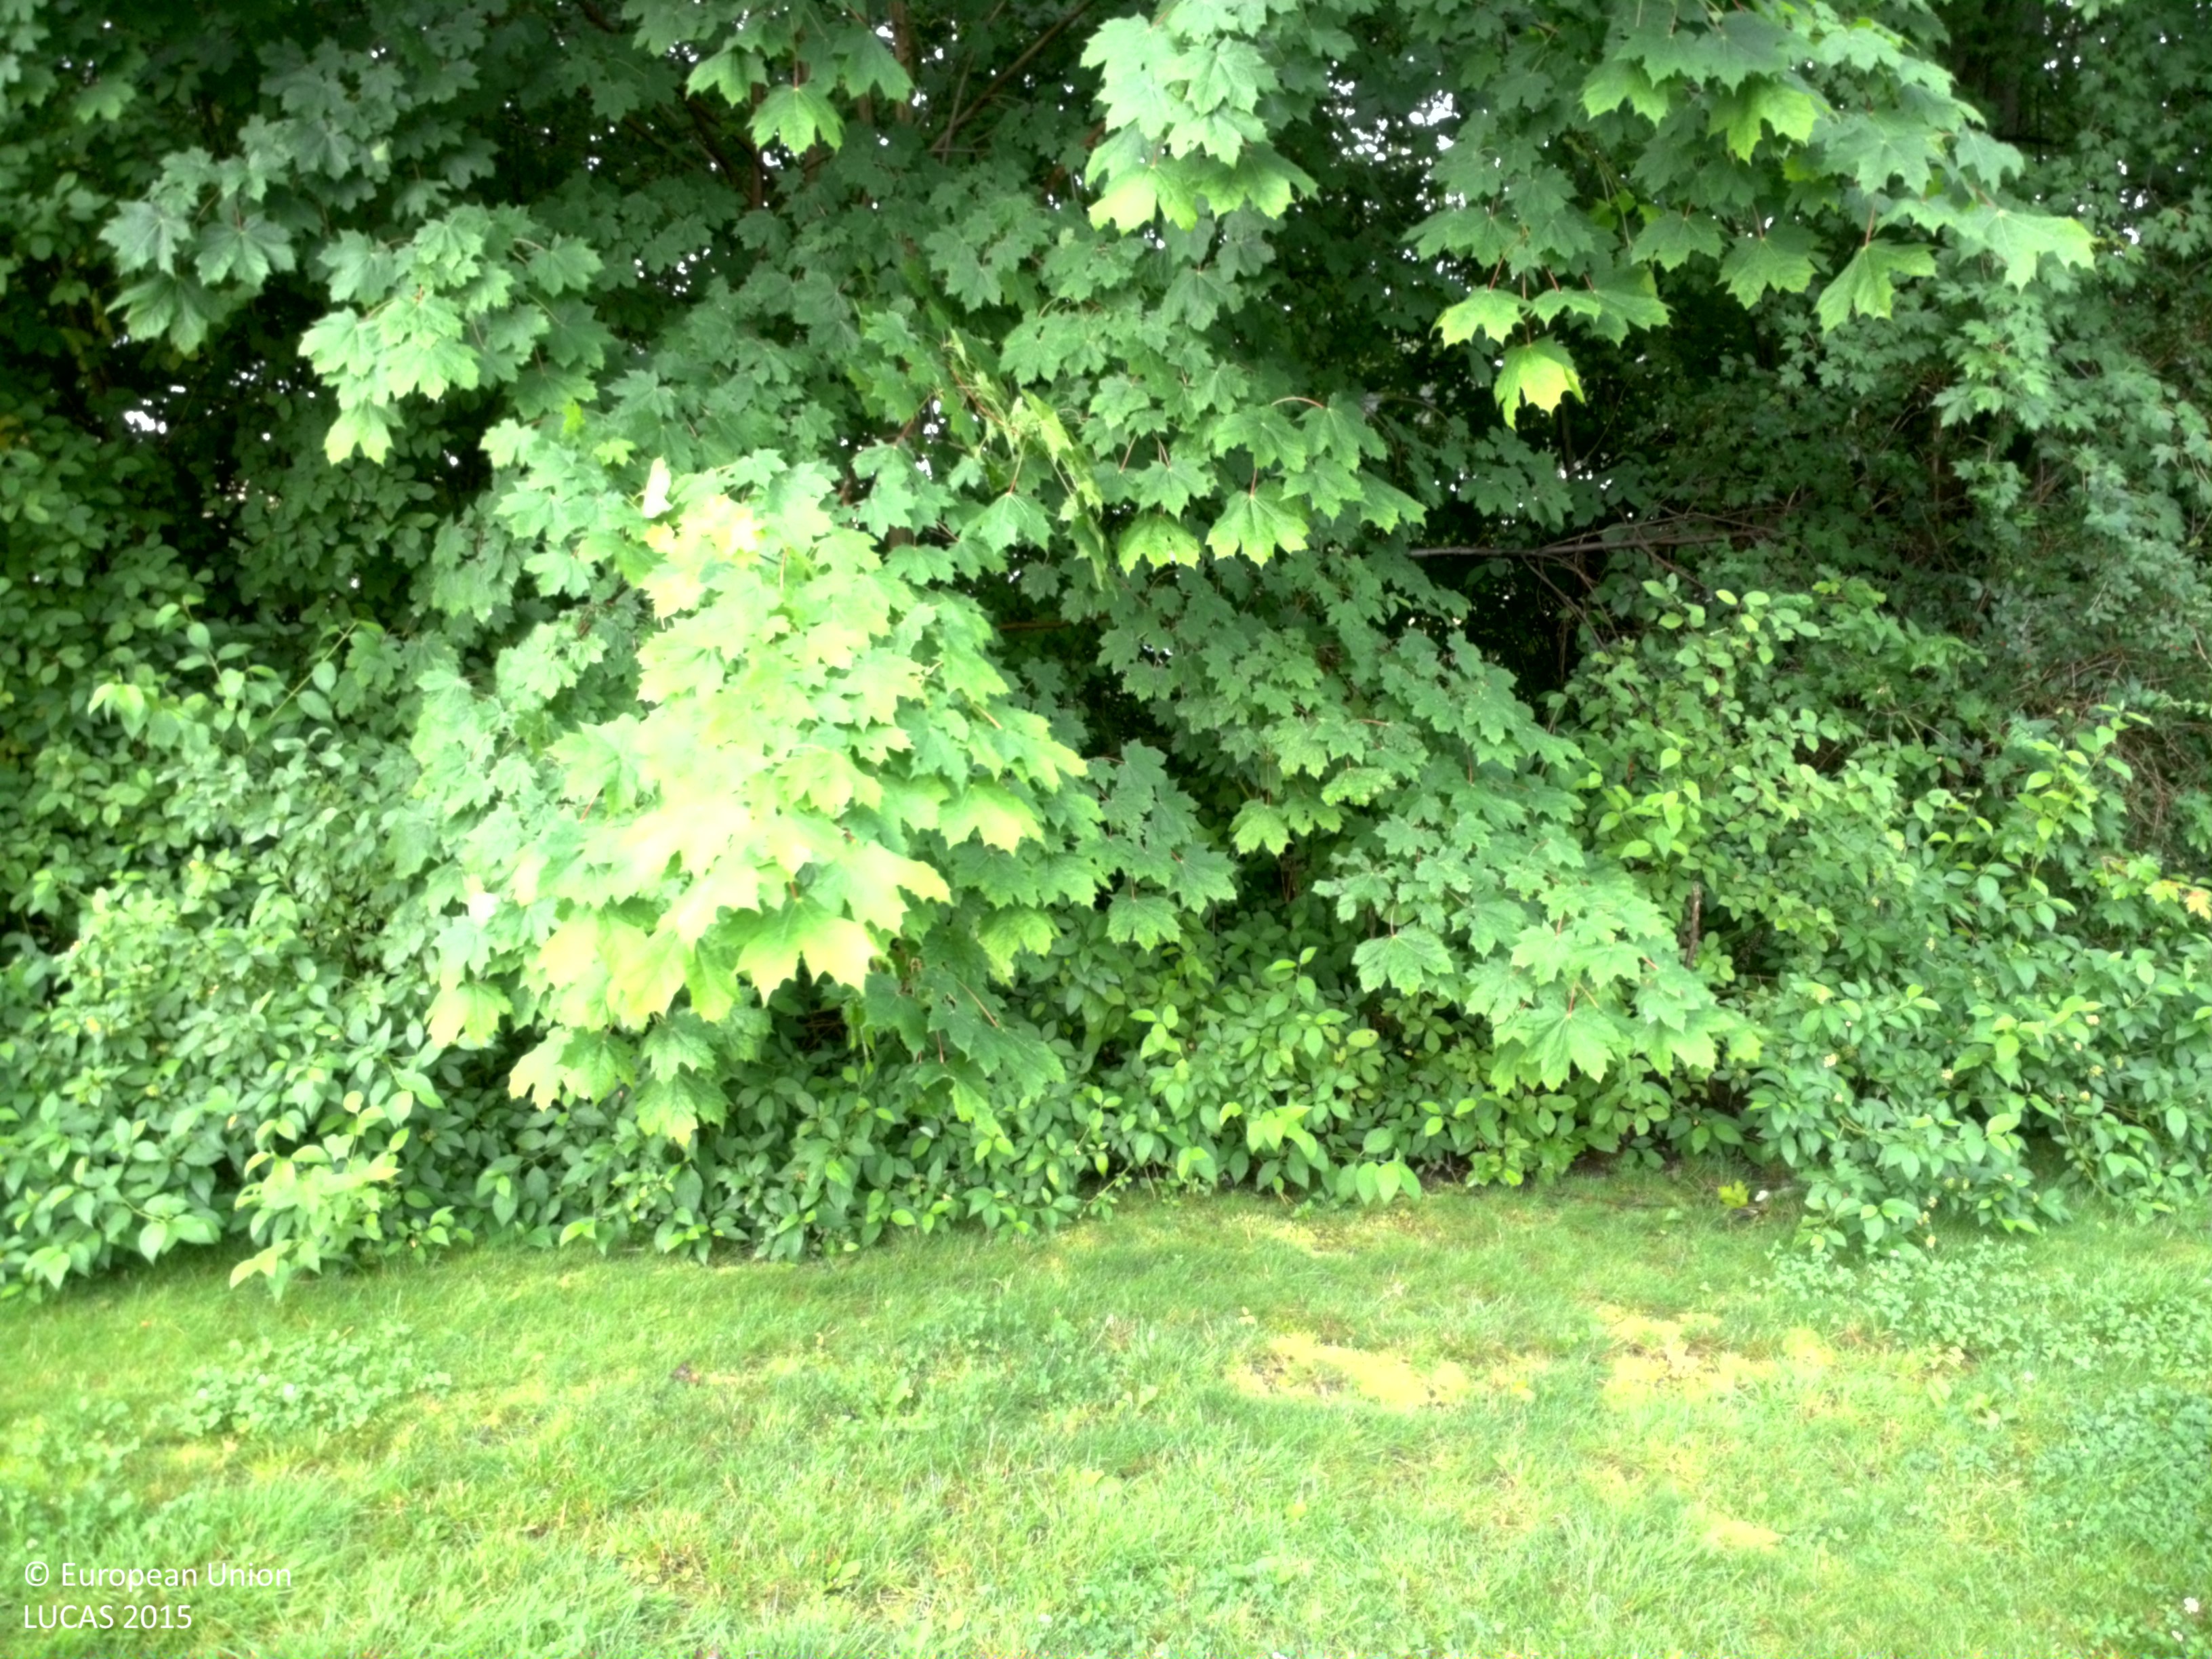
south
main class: Grassland
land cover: Grassland without tree/shrub cover
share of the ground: > 75 %
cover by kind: herbaceous plants 90 %
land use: Commerce
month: July
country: SE
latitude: 59.3816
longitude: 13.4599
